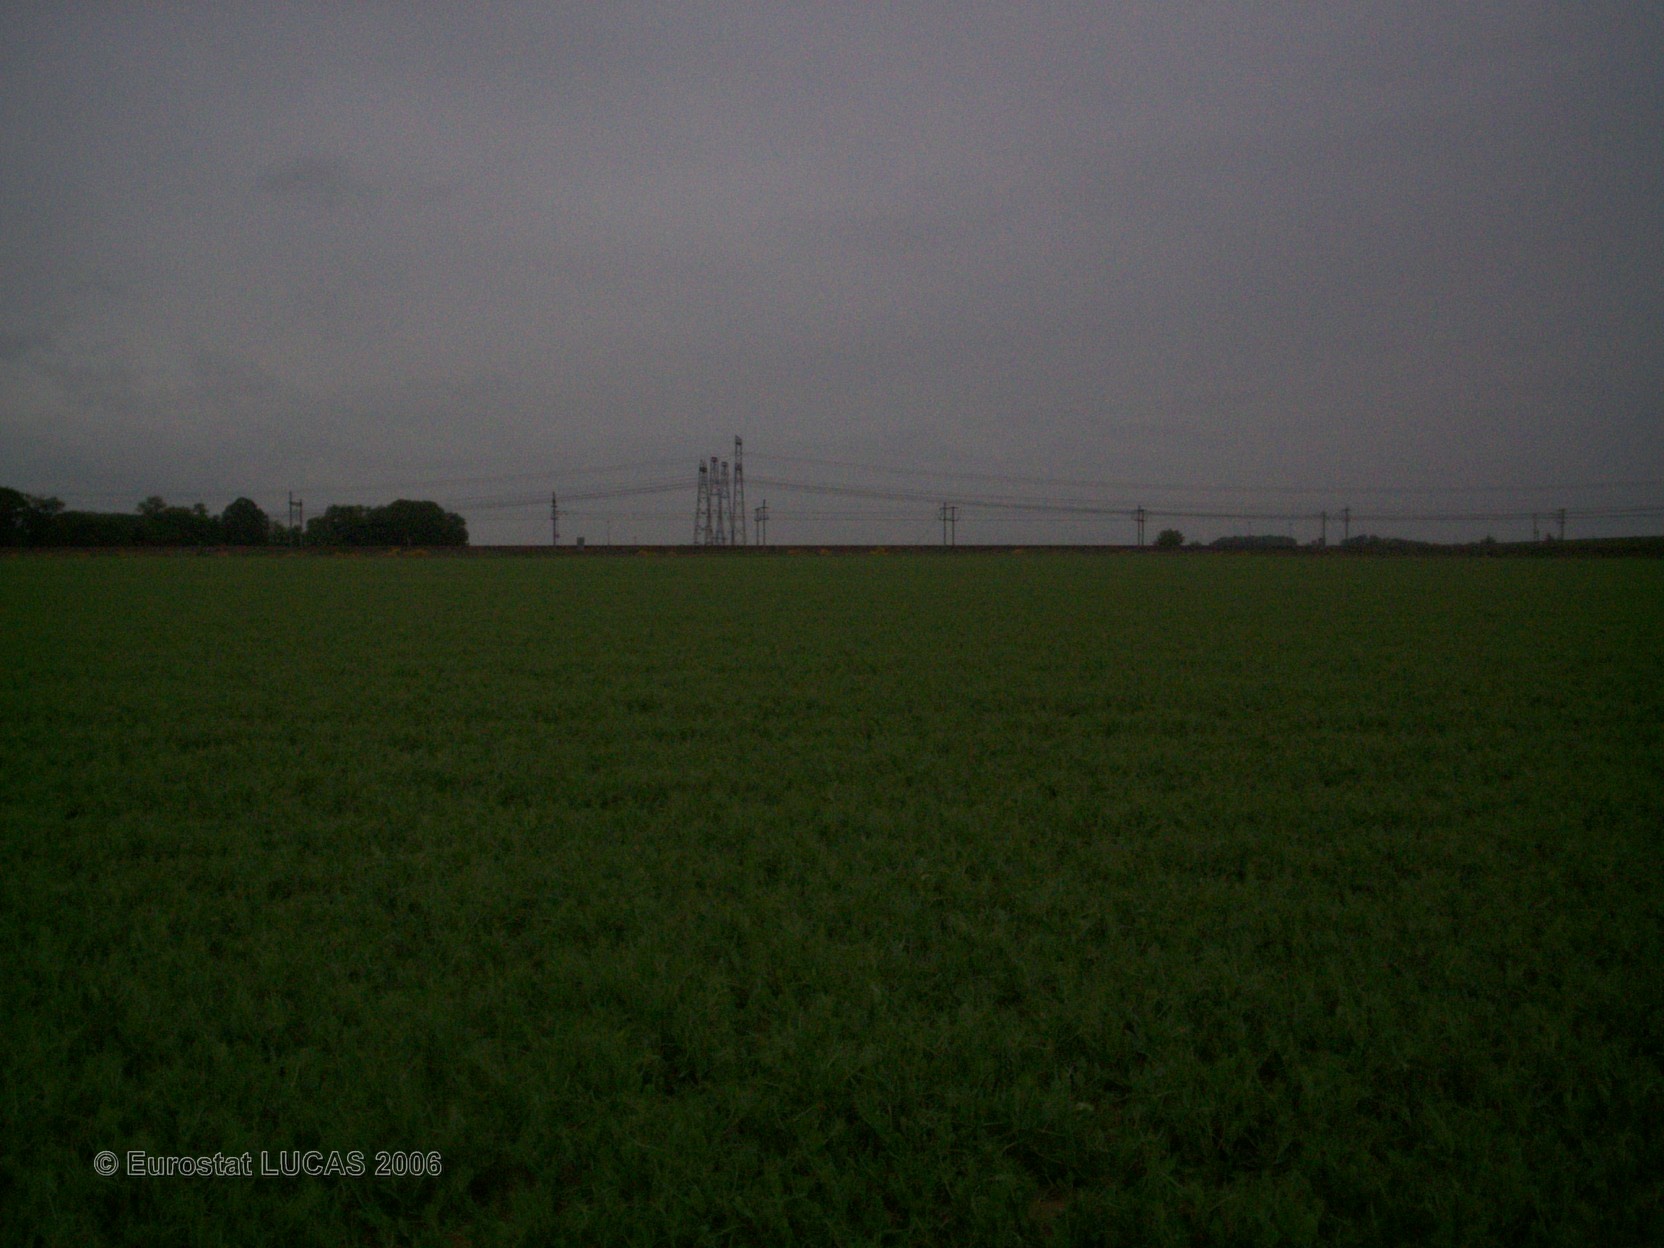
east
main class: Cropland
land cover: Dry pulses
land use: Agriculture (excluding fallow land and kitchen gardens)
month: May
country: FR
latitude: 48.6695
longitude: 2.7254
